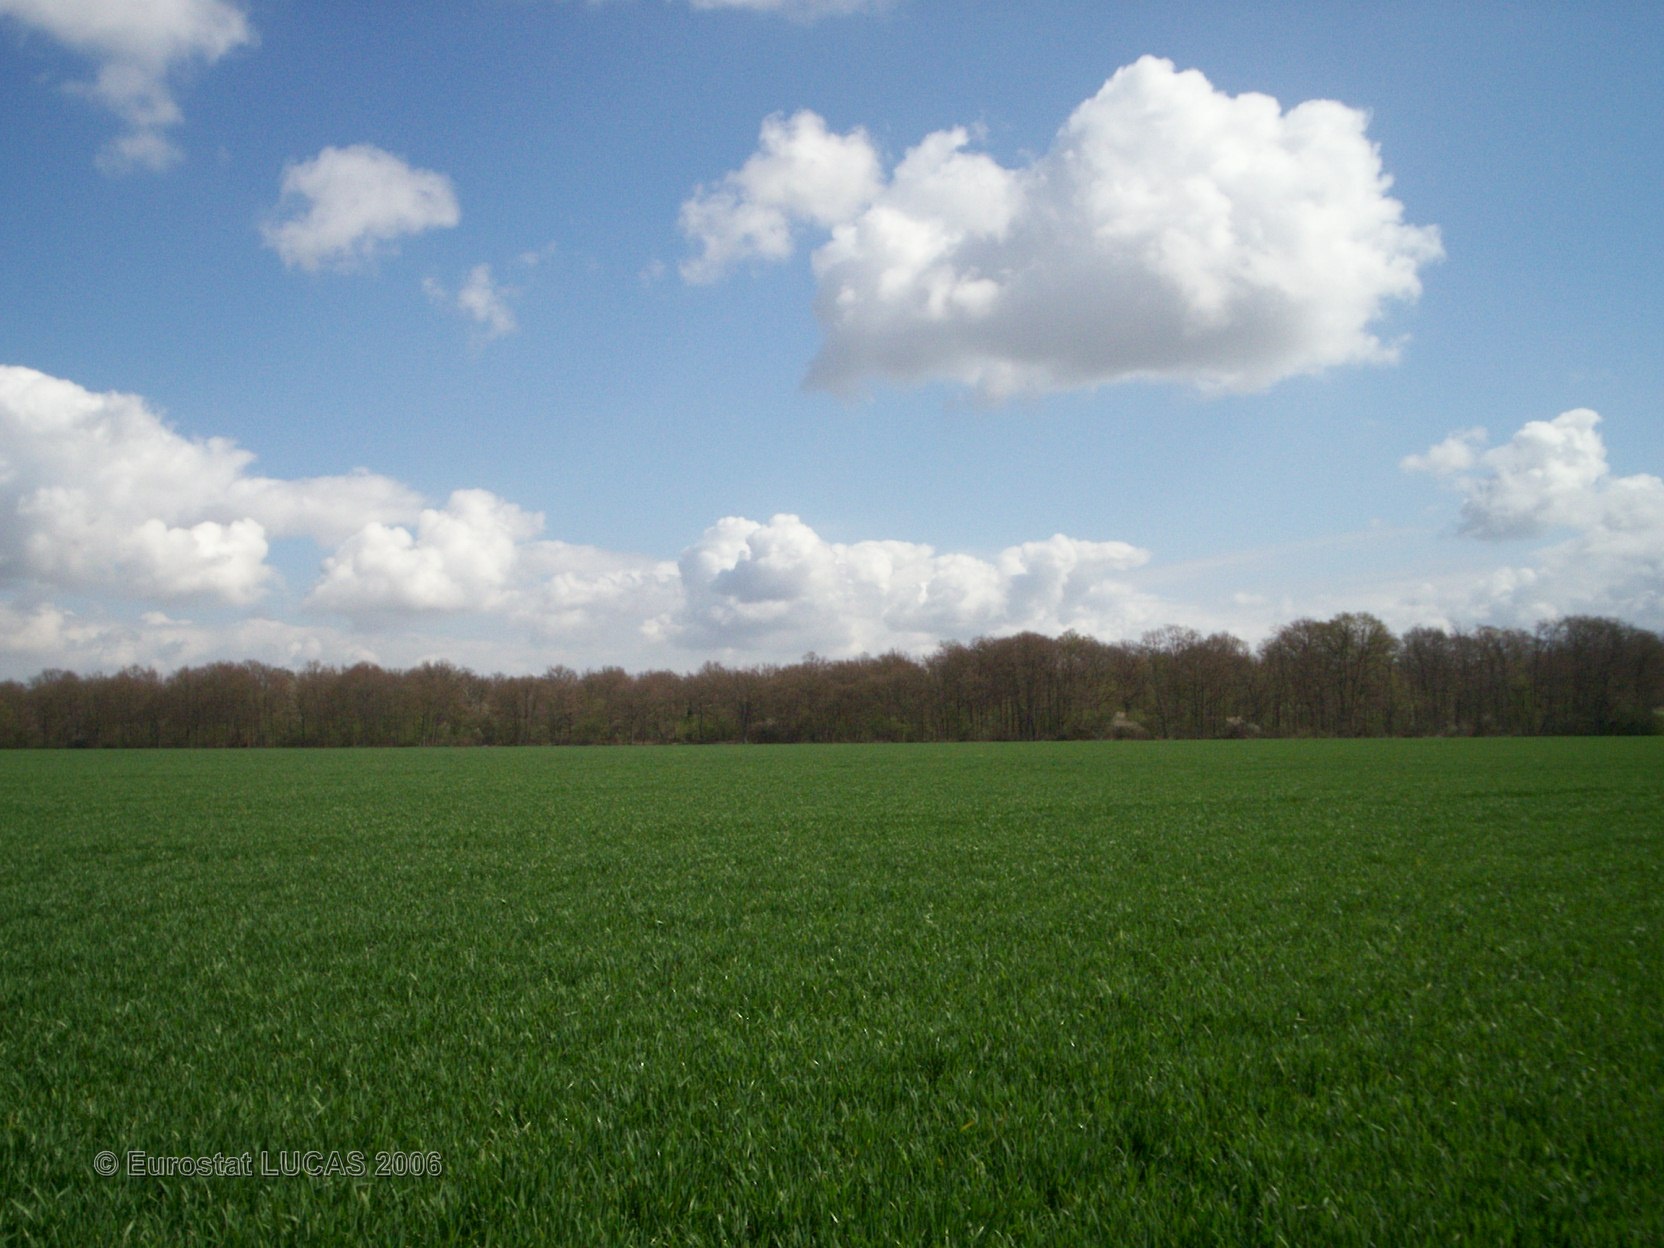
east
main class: Cropland
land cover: Common wheat
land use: Agriculture (excluding fallow land and kitchen gardens)
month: April
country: FR
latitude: 48.4906
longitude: 2.7515
